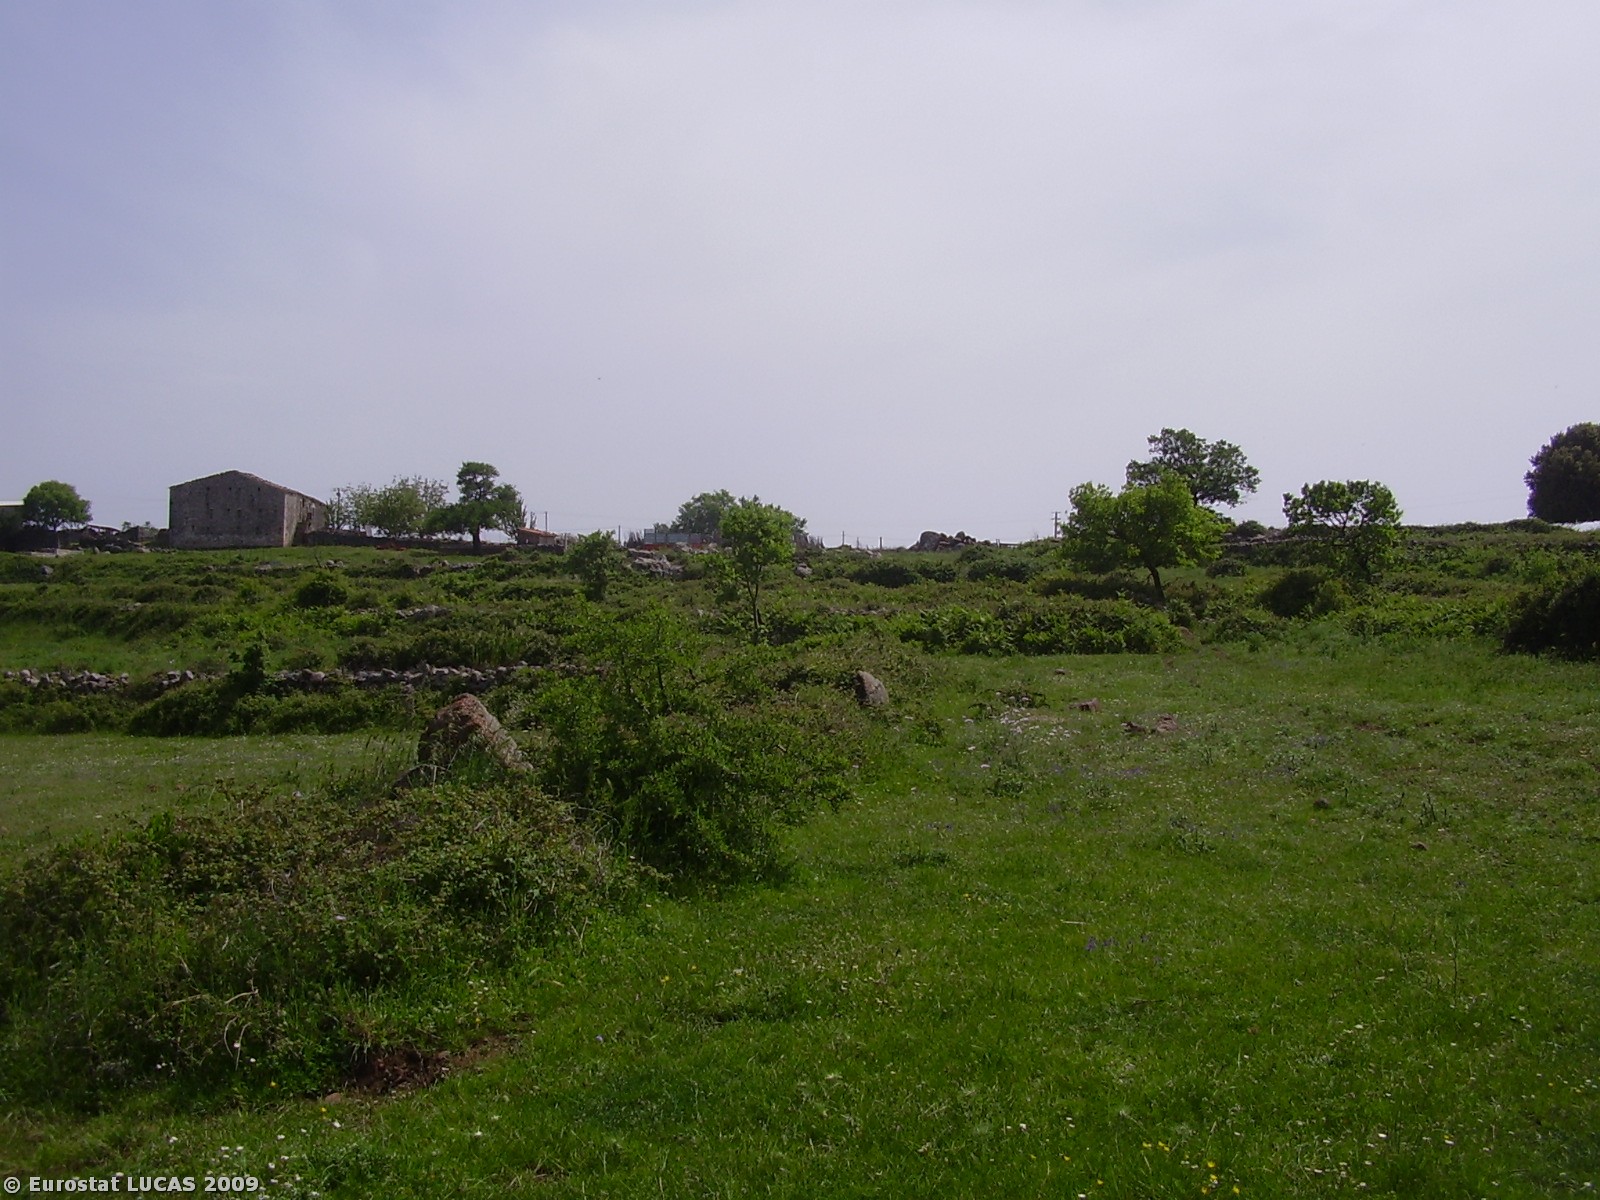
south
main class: Grassland
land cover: Grassland without tree/shrub cover
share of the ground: > 75 %
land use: Agriculture (excluding fallow land and kitchen gardens)
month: May
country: IT
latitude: 37.1299
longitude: 14.9040
